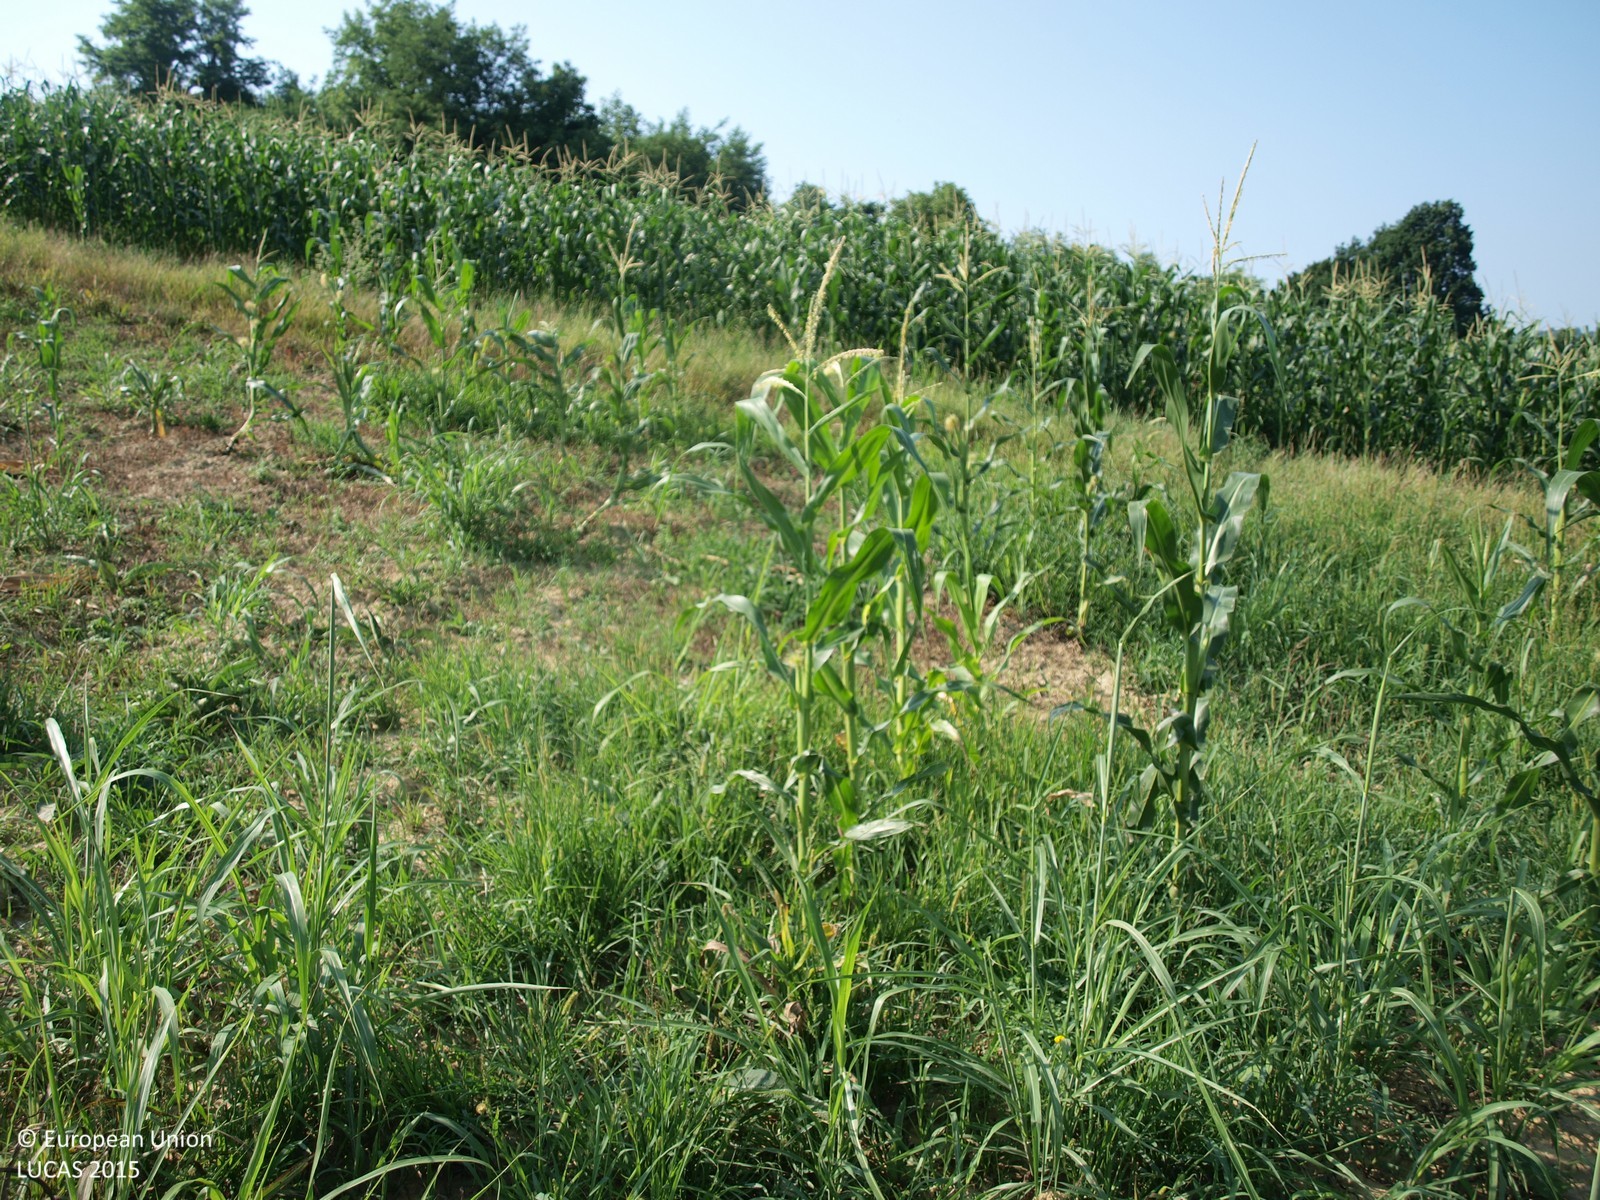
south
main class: Cropland
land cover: Maize
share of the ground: 10 - 25 %
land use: Agriculture (excluding fallow land and kitchen gardens)
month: July
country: HR
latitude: 46.1320
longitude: 15.9396
